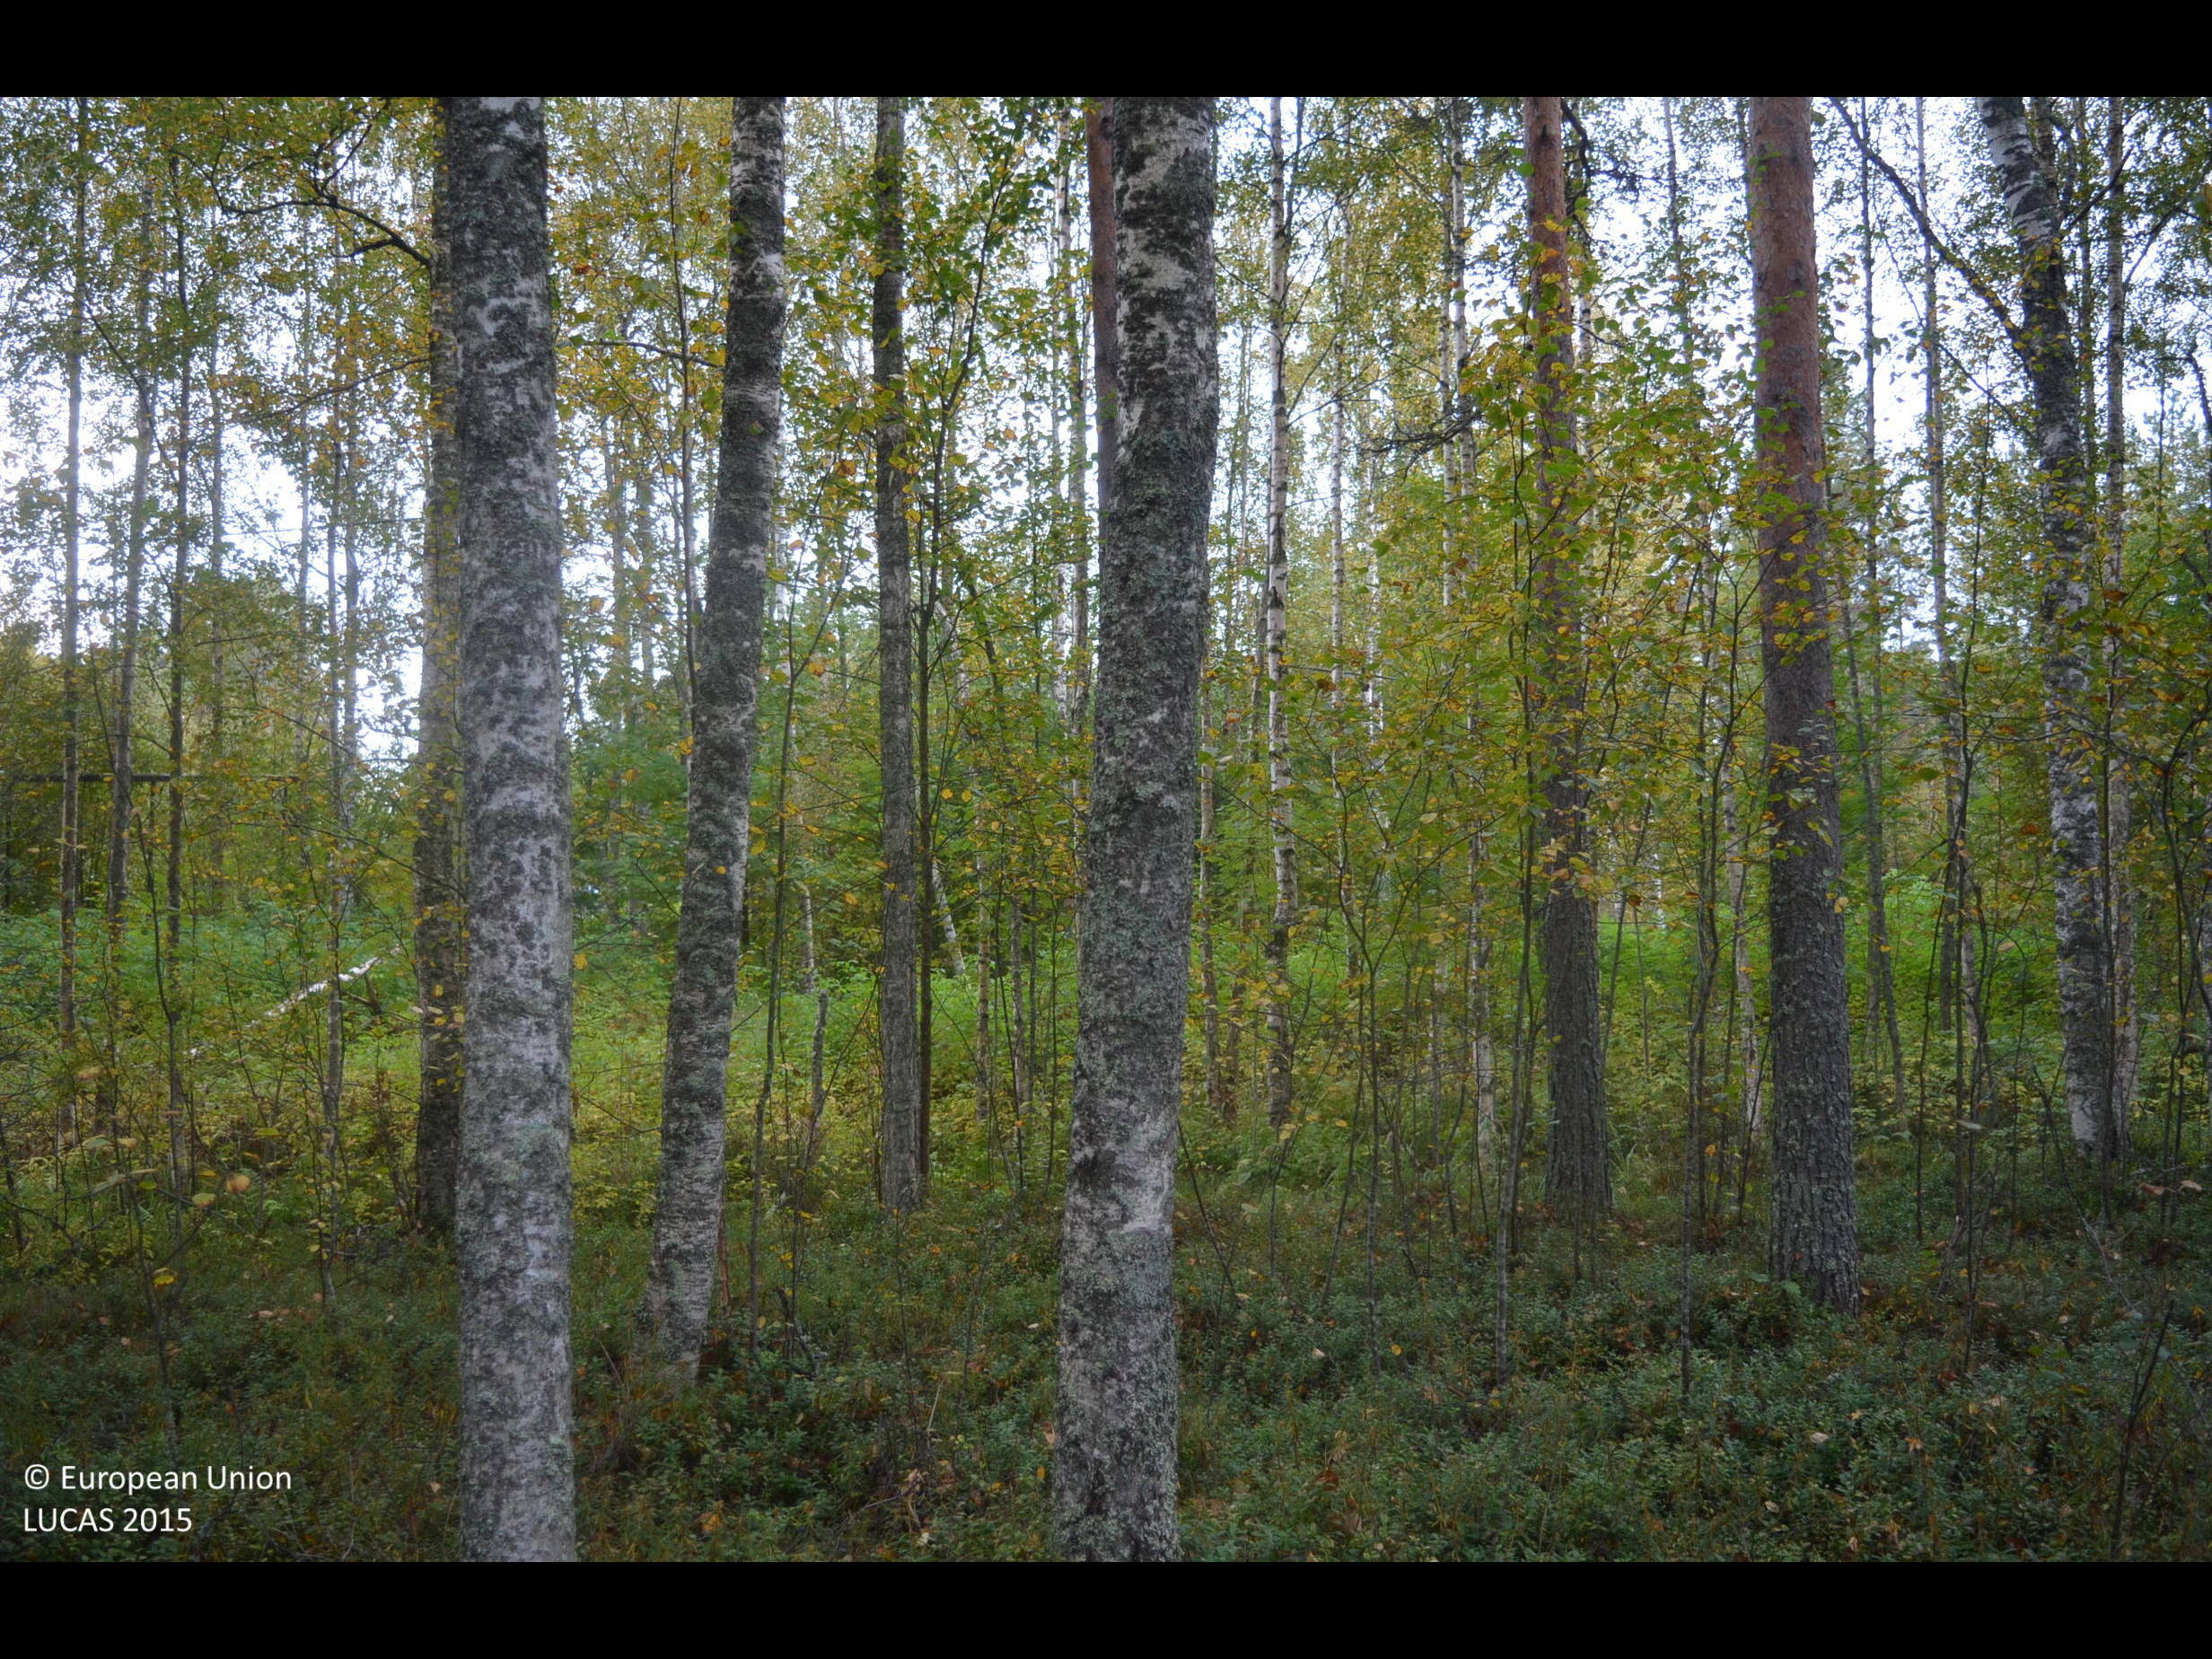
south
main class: Woodland
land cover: Pine dominated mixed woodland
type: boreal forest
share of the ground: > 75 %
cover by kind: broadleaved forest trees 40 %, coniferous forest trees 35 %, shrubs 25 %
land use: Forestry
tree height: > 5 m
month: September
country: FI
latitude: 63.0017
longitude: 23.7943
